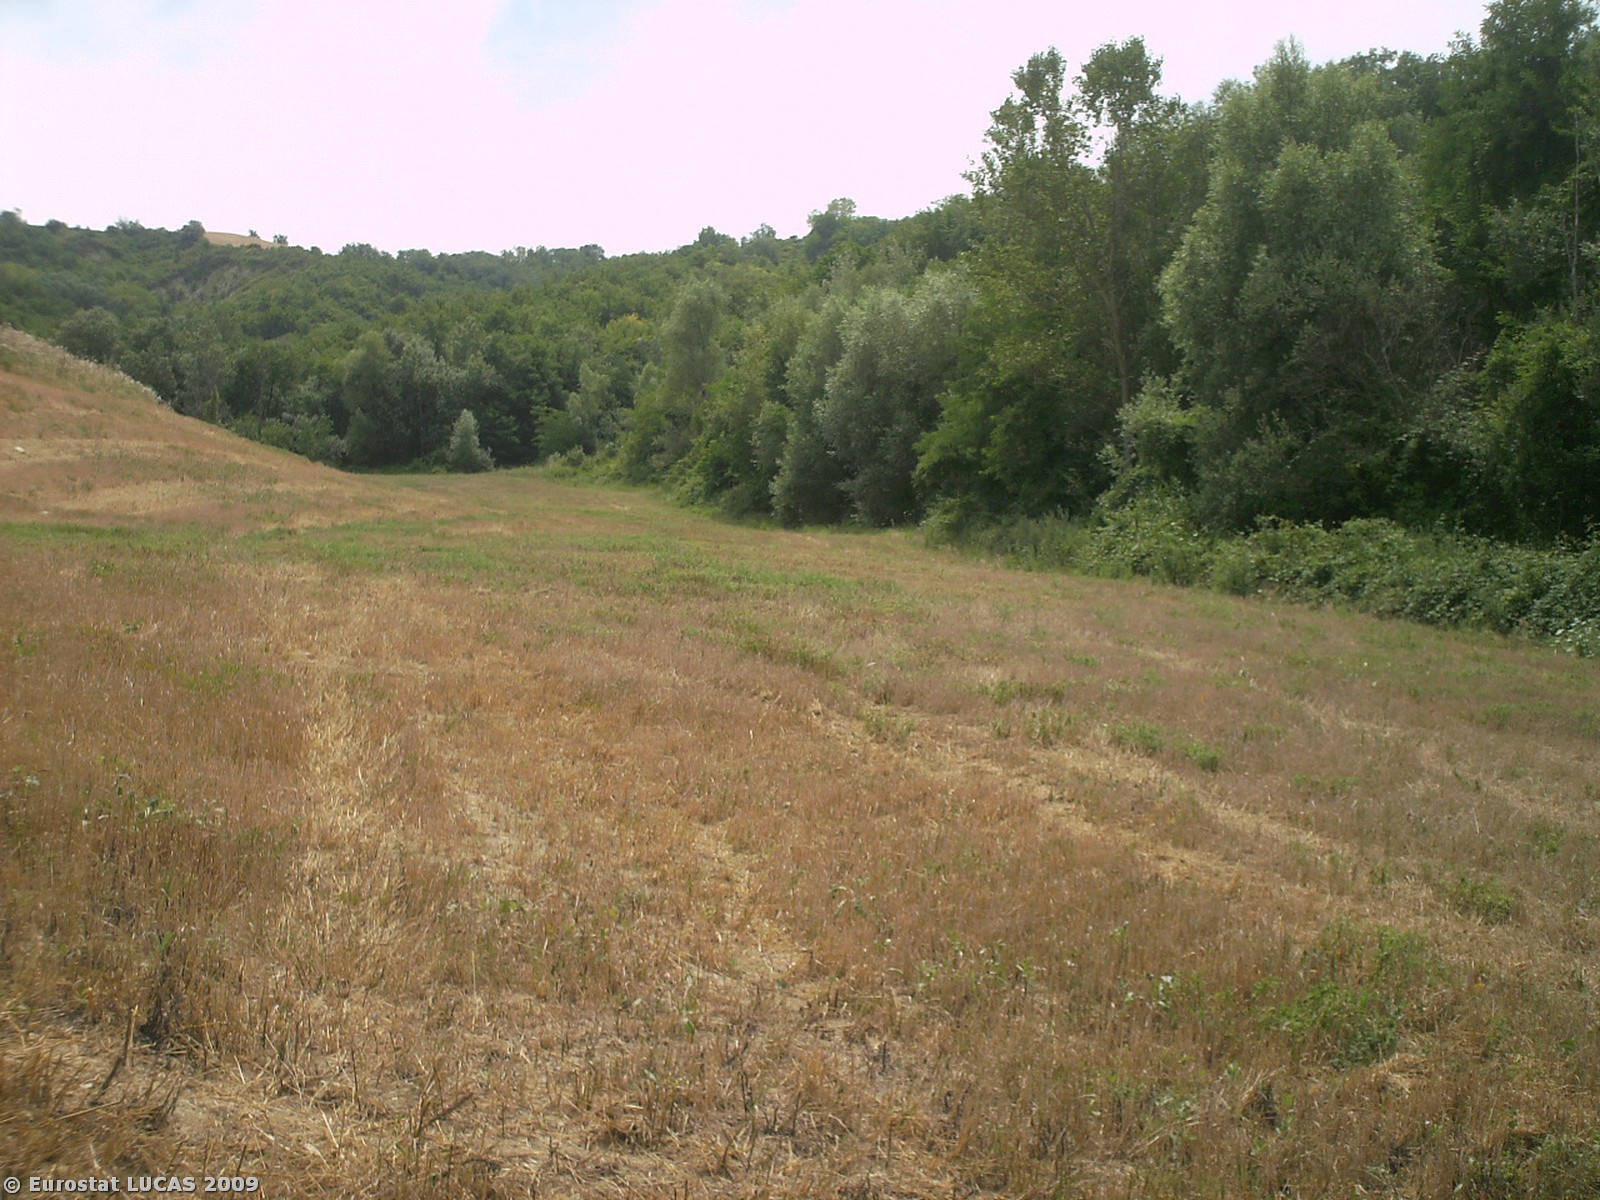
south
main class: Cropland
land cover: Durum wheat
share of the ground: < 10 %
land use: Agriculture (excluding fallow land and kitchen gardens)
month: July
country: IT
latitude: 43.7883
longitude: 12.8390
